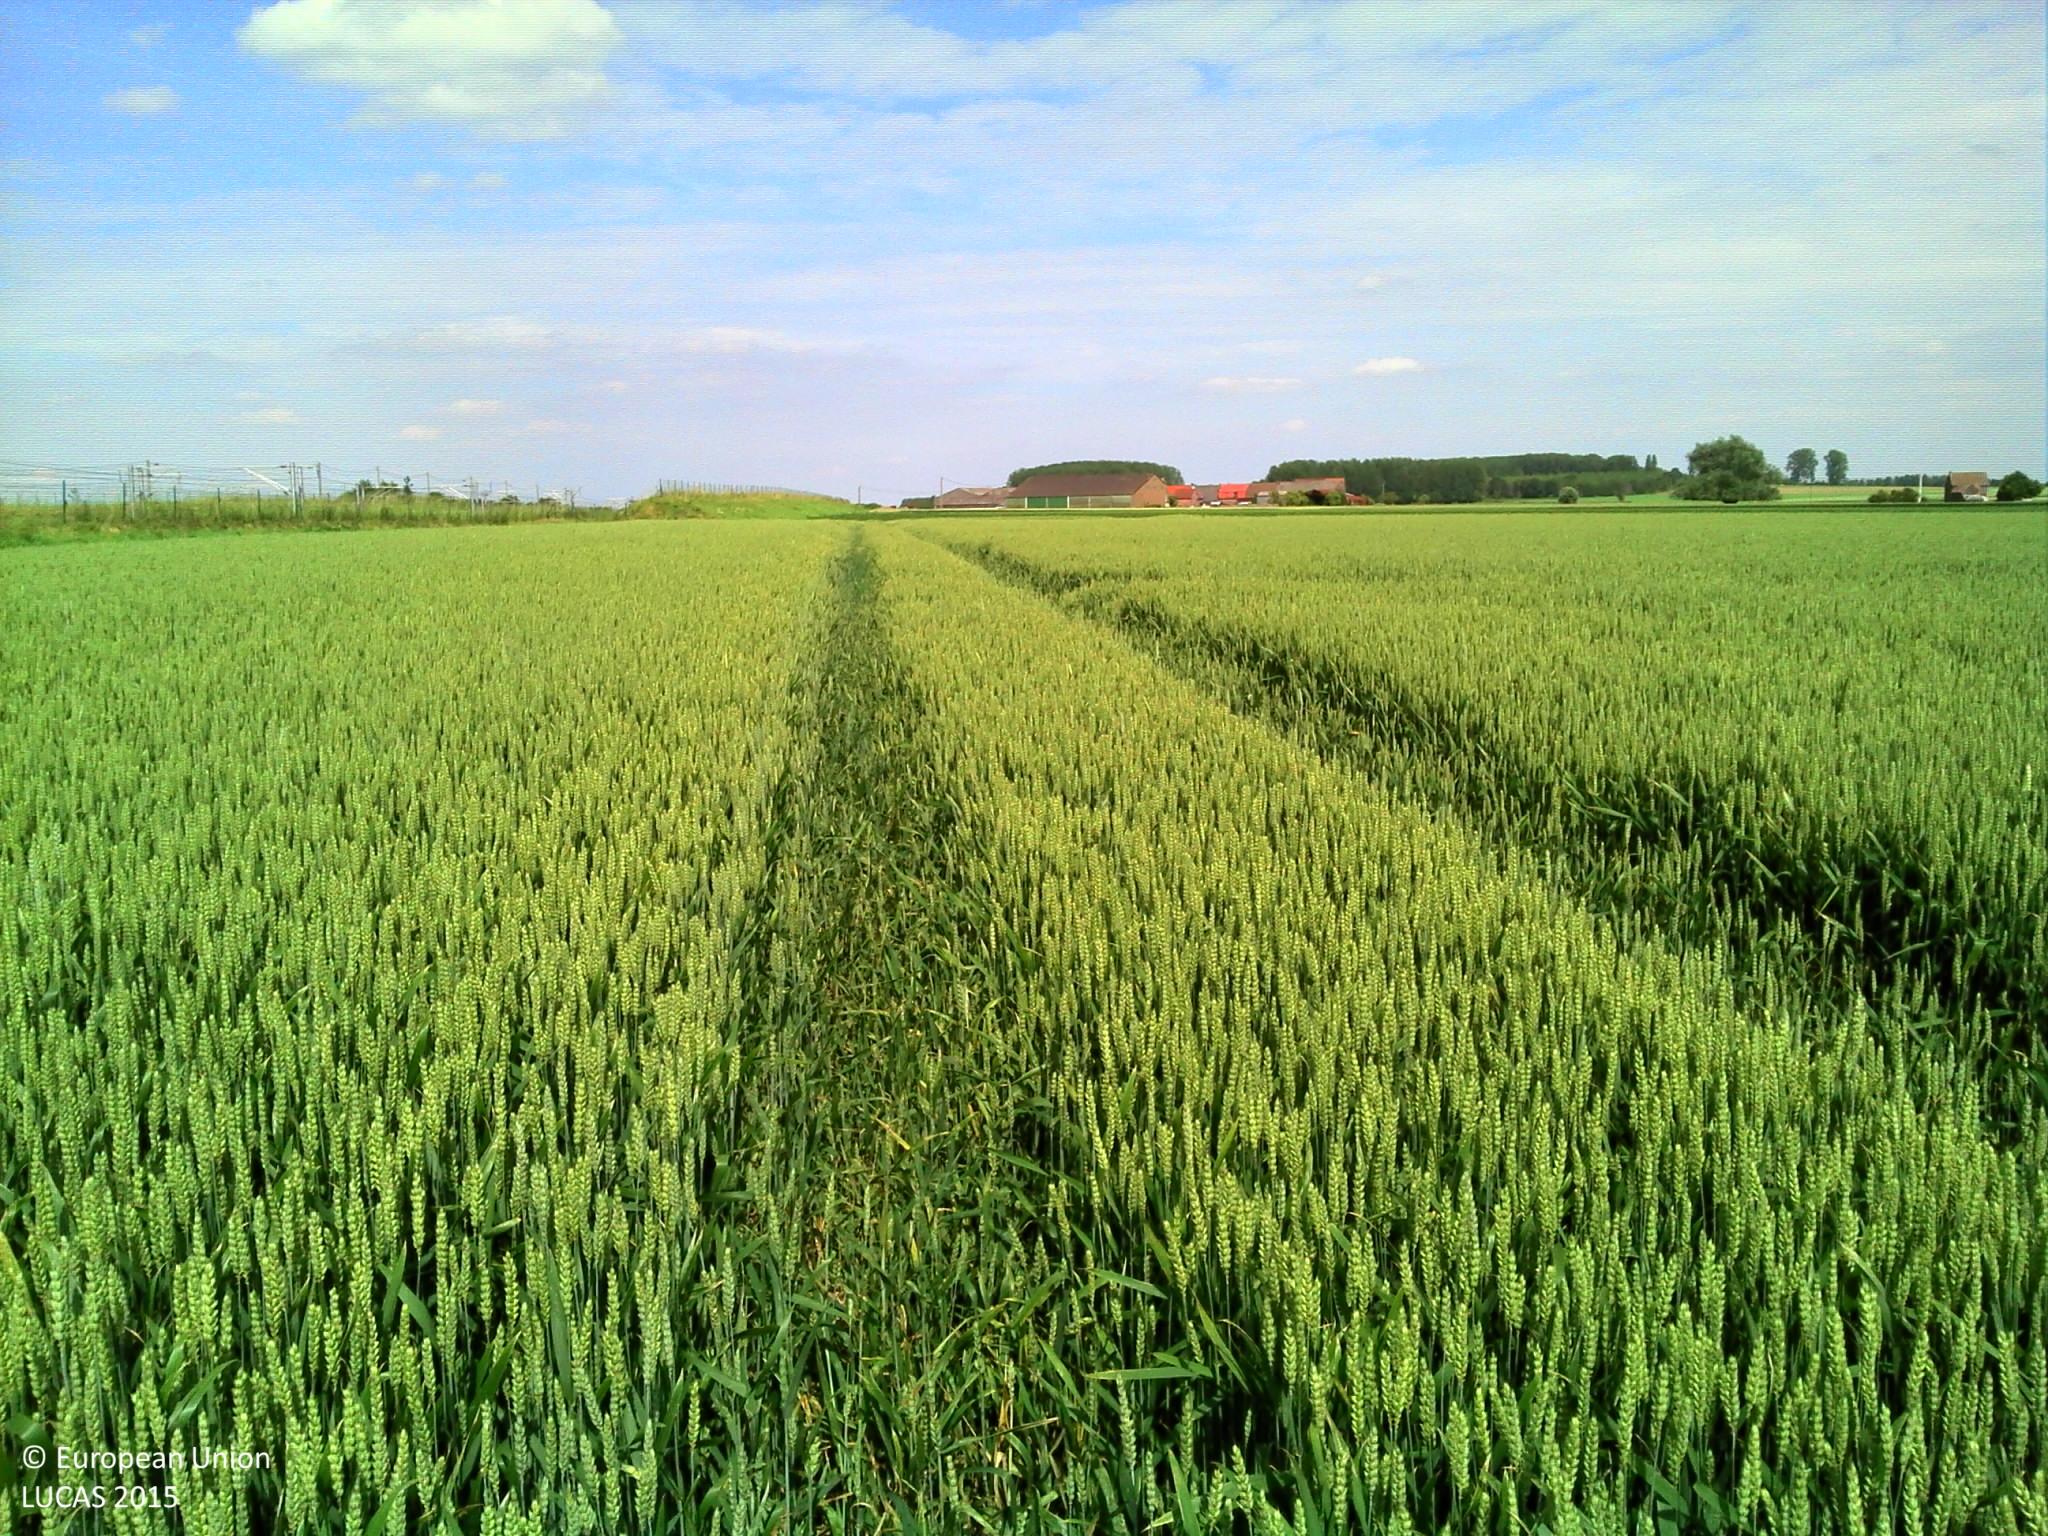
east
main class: Cropland
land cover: Common wheat
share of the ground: > 75 %
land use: Agriculture (excluding fallow land and kitchen gardens)
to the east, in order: Common wheat; Potatoes; Maize
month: June
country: BE
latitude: 50.5682
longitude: 3.6819
